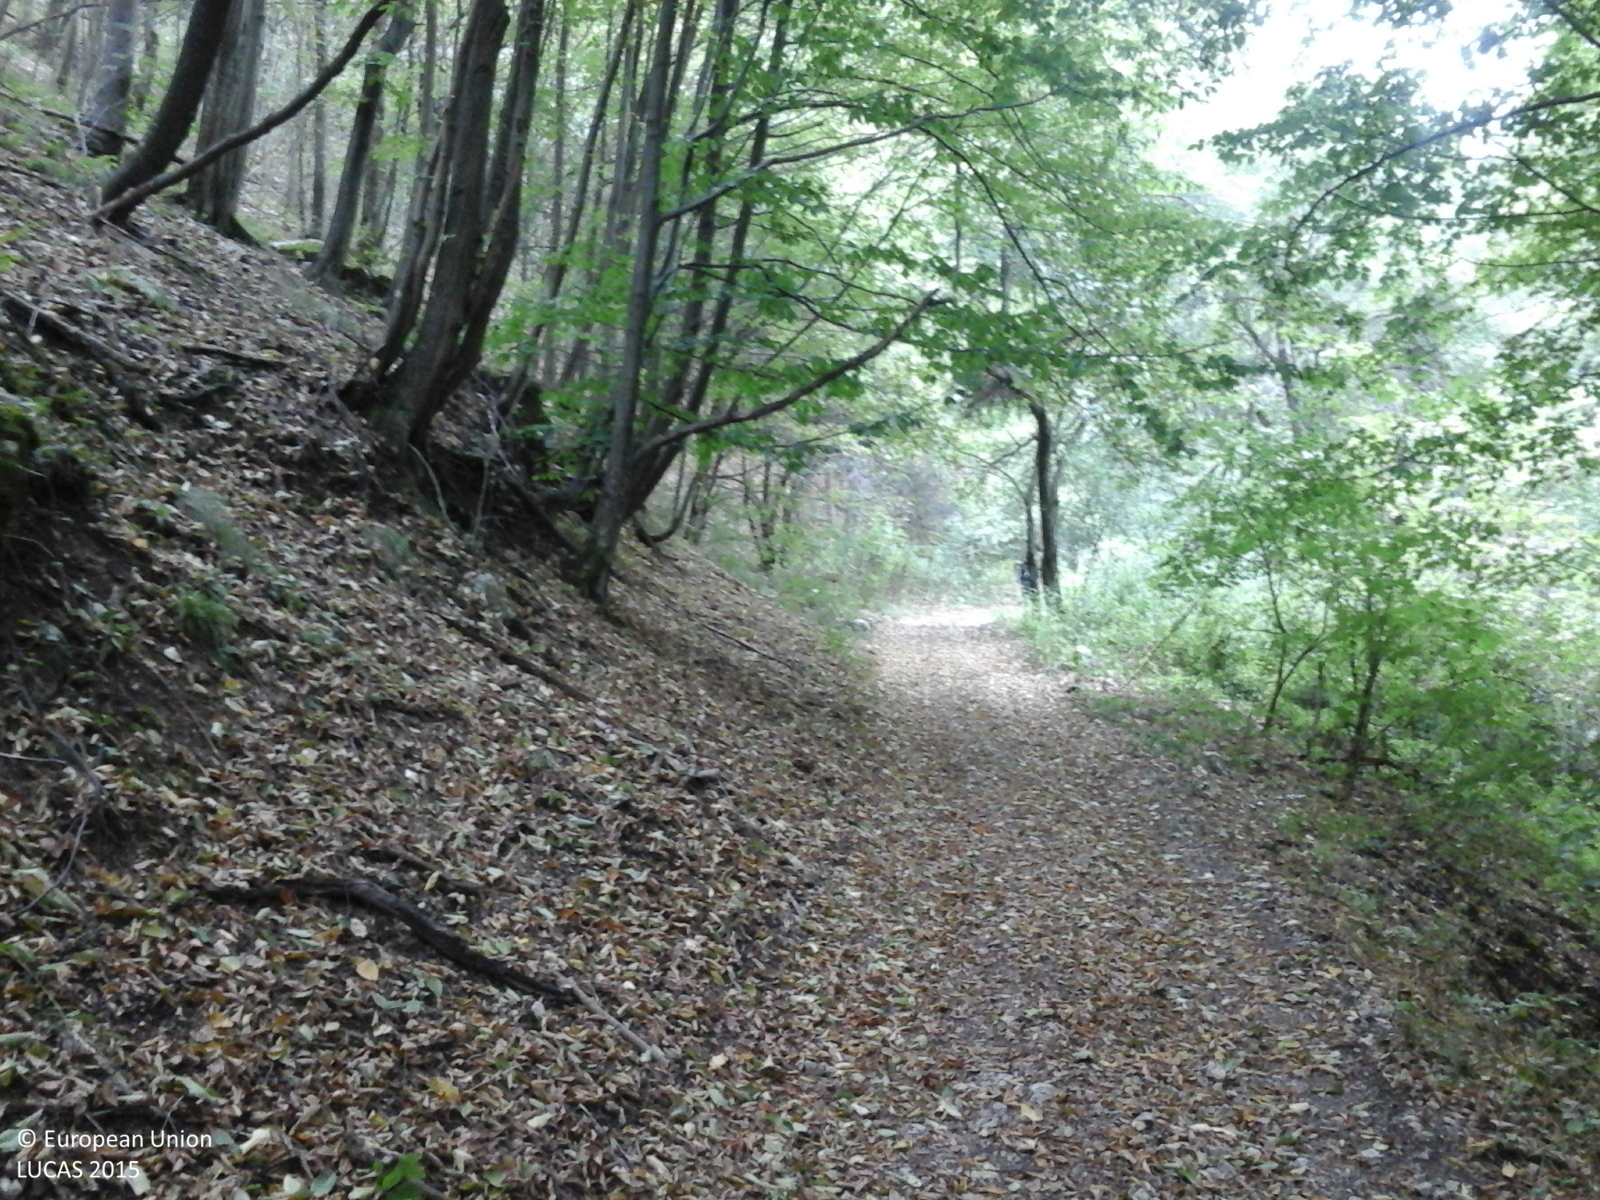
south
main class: Woodland
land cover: Broadleaved woodland
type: beech forest
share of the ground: > 75 %
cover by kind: broadleaved forest trees 100 %
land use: Forestry
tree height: > 5 m
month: August
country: RO
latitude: 45.1262
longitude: 21.8453
